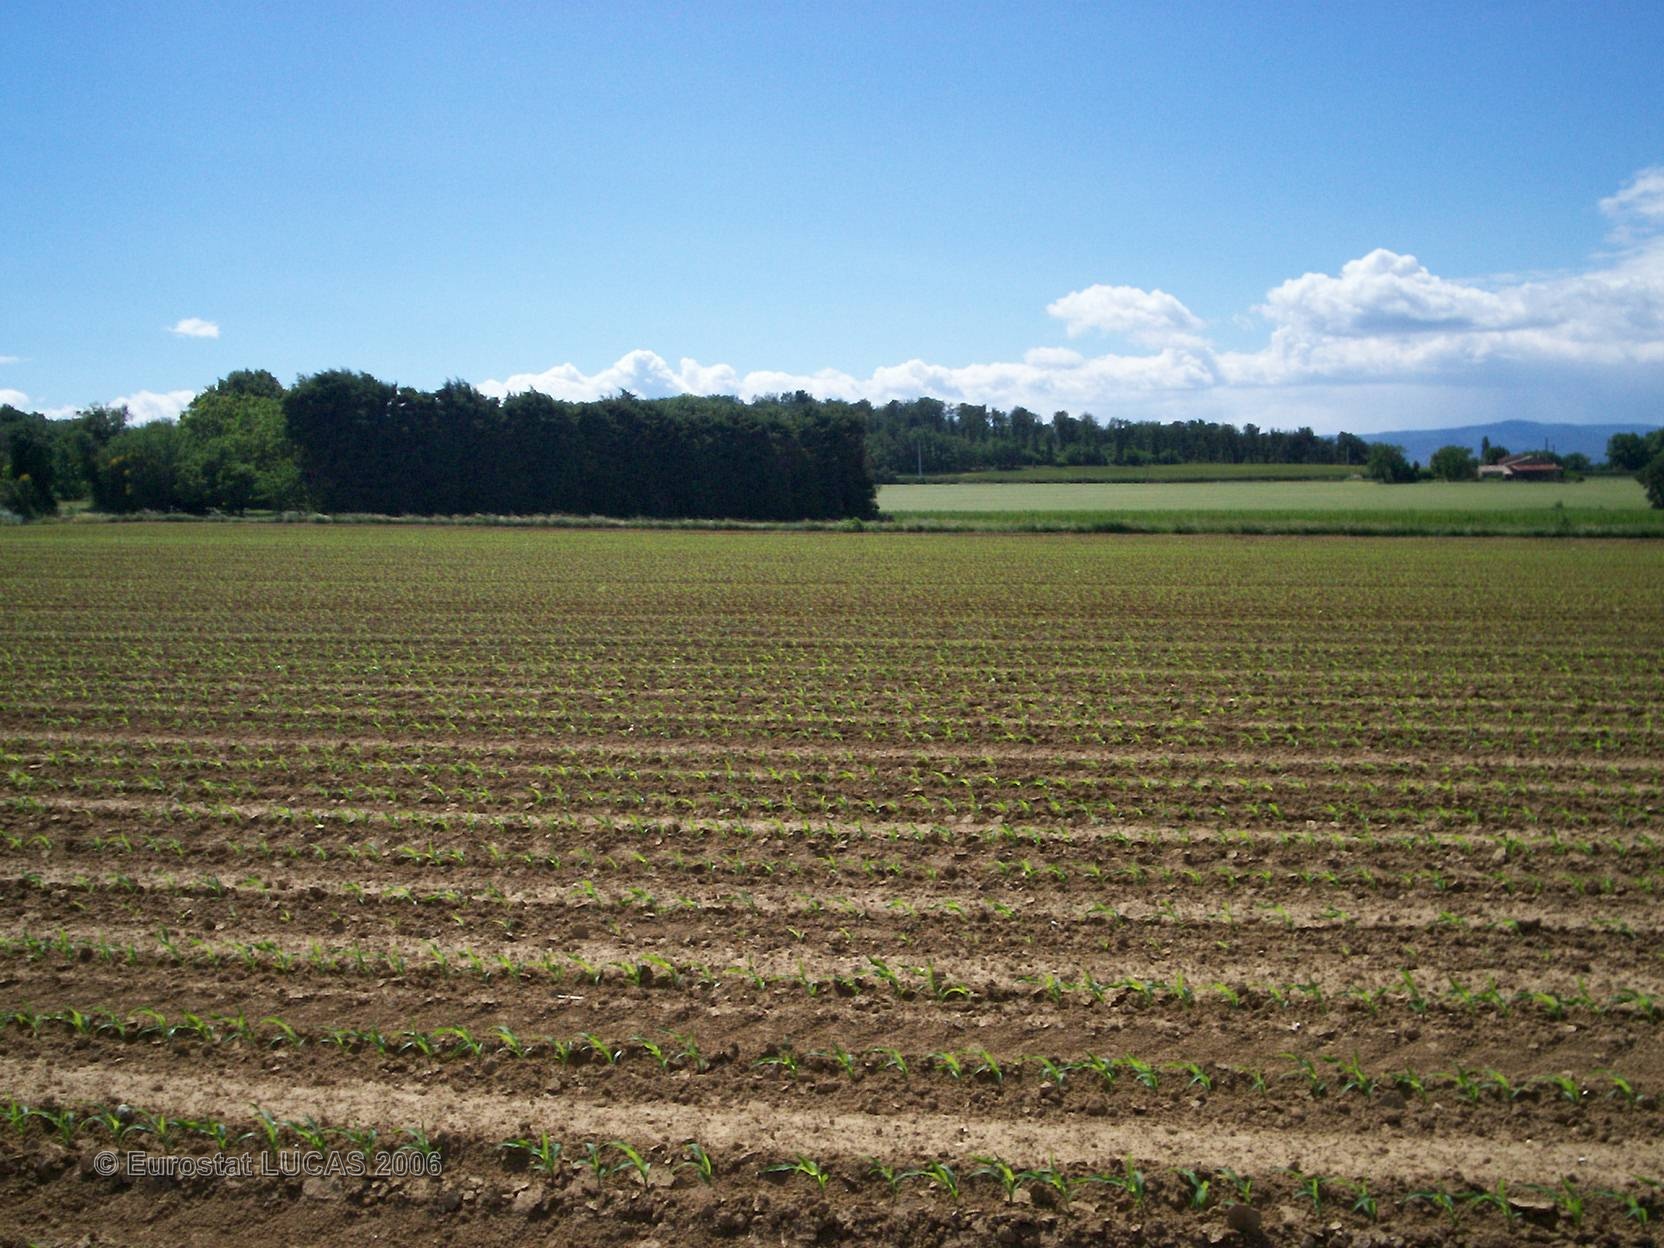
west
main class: Cropland
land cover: Maize
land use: Agriculture (excluding fallow land and kitchen gardens)
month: May
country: FR
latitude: 44.5663
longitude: 4.8569
